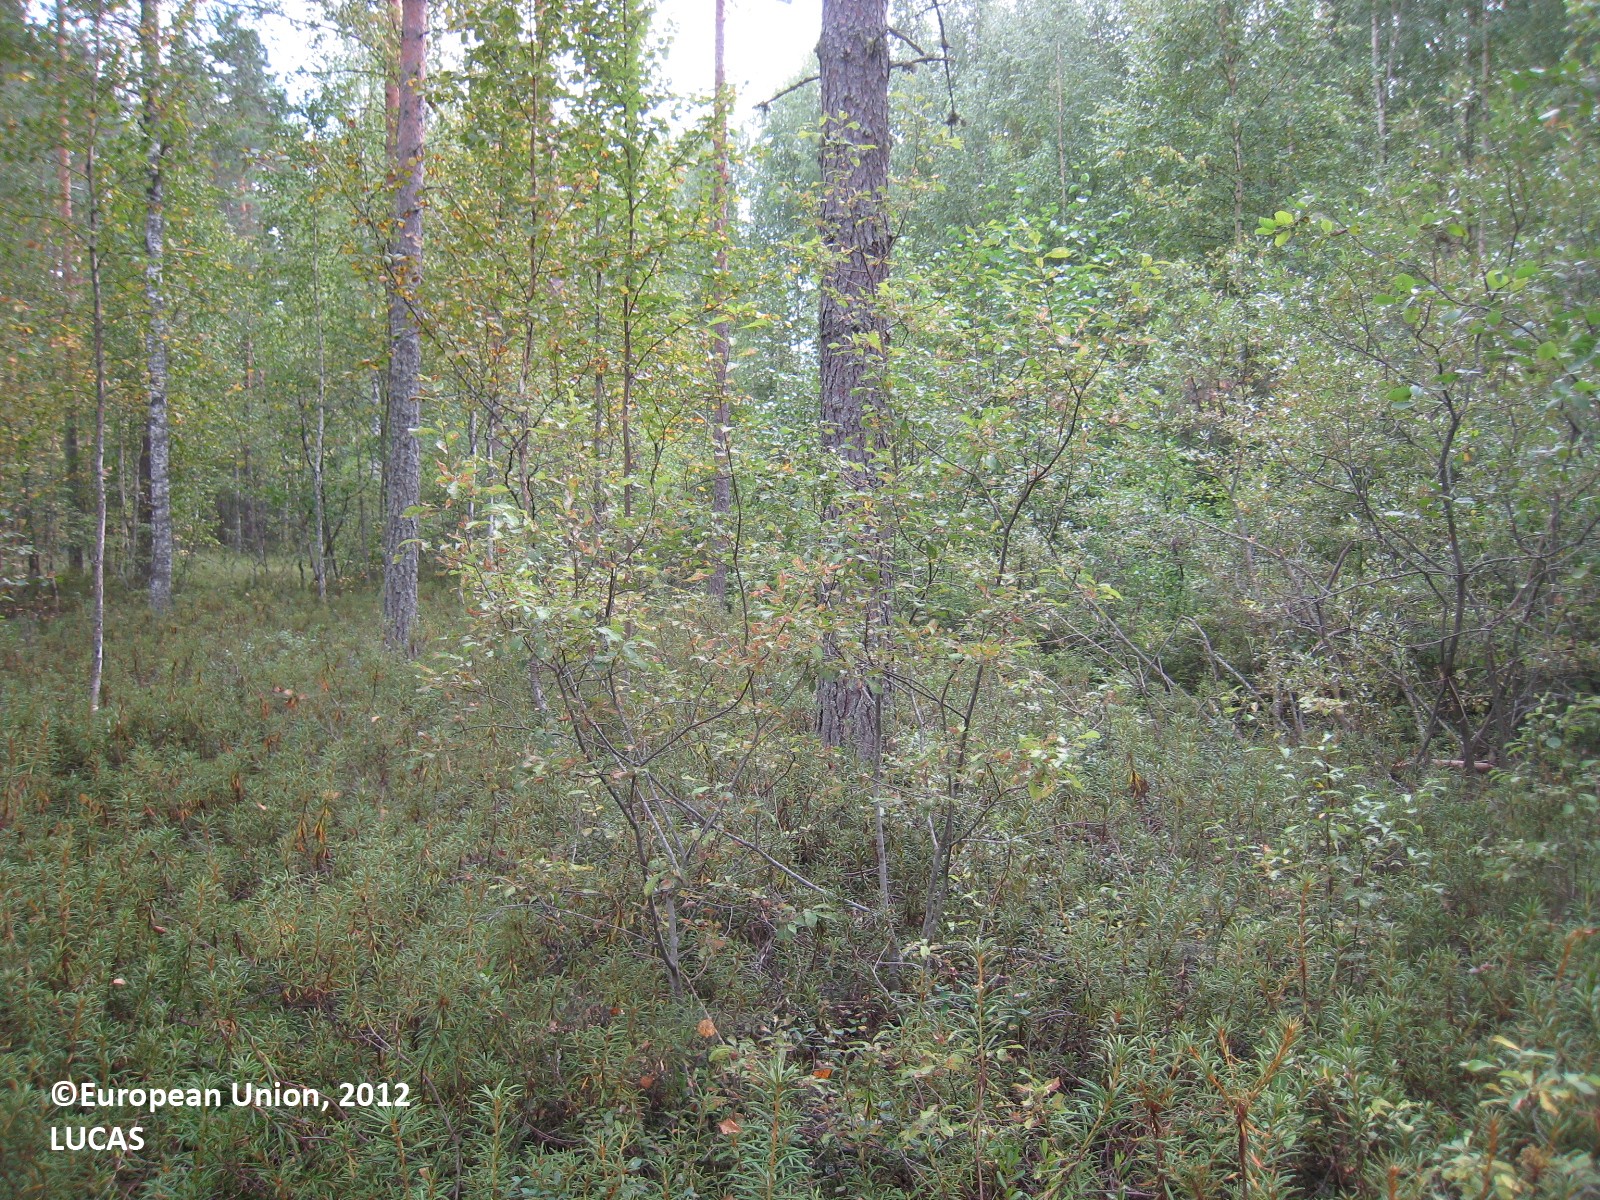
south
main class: Woodland
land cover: Pine dominated mixed woodland
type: mire and swamp forests
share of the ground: 50 - 75 %
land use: Forestry
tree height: > 5 m
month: August
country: FI
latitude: 62.2068
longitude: 27.1736
